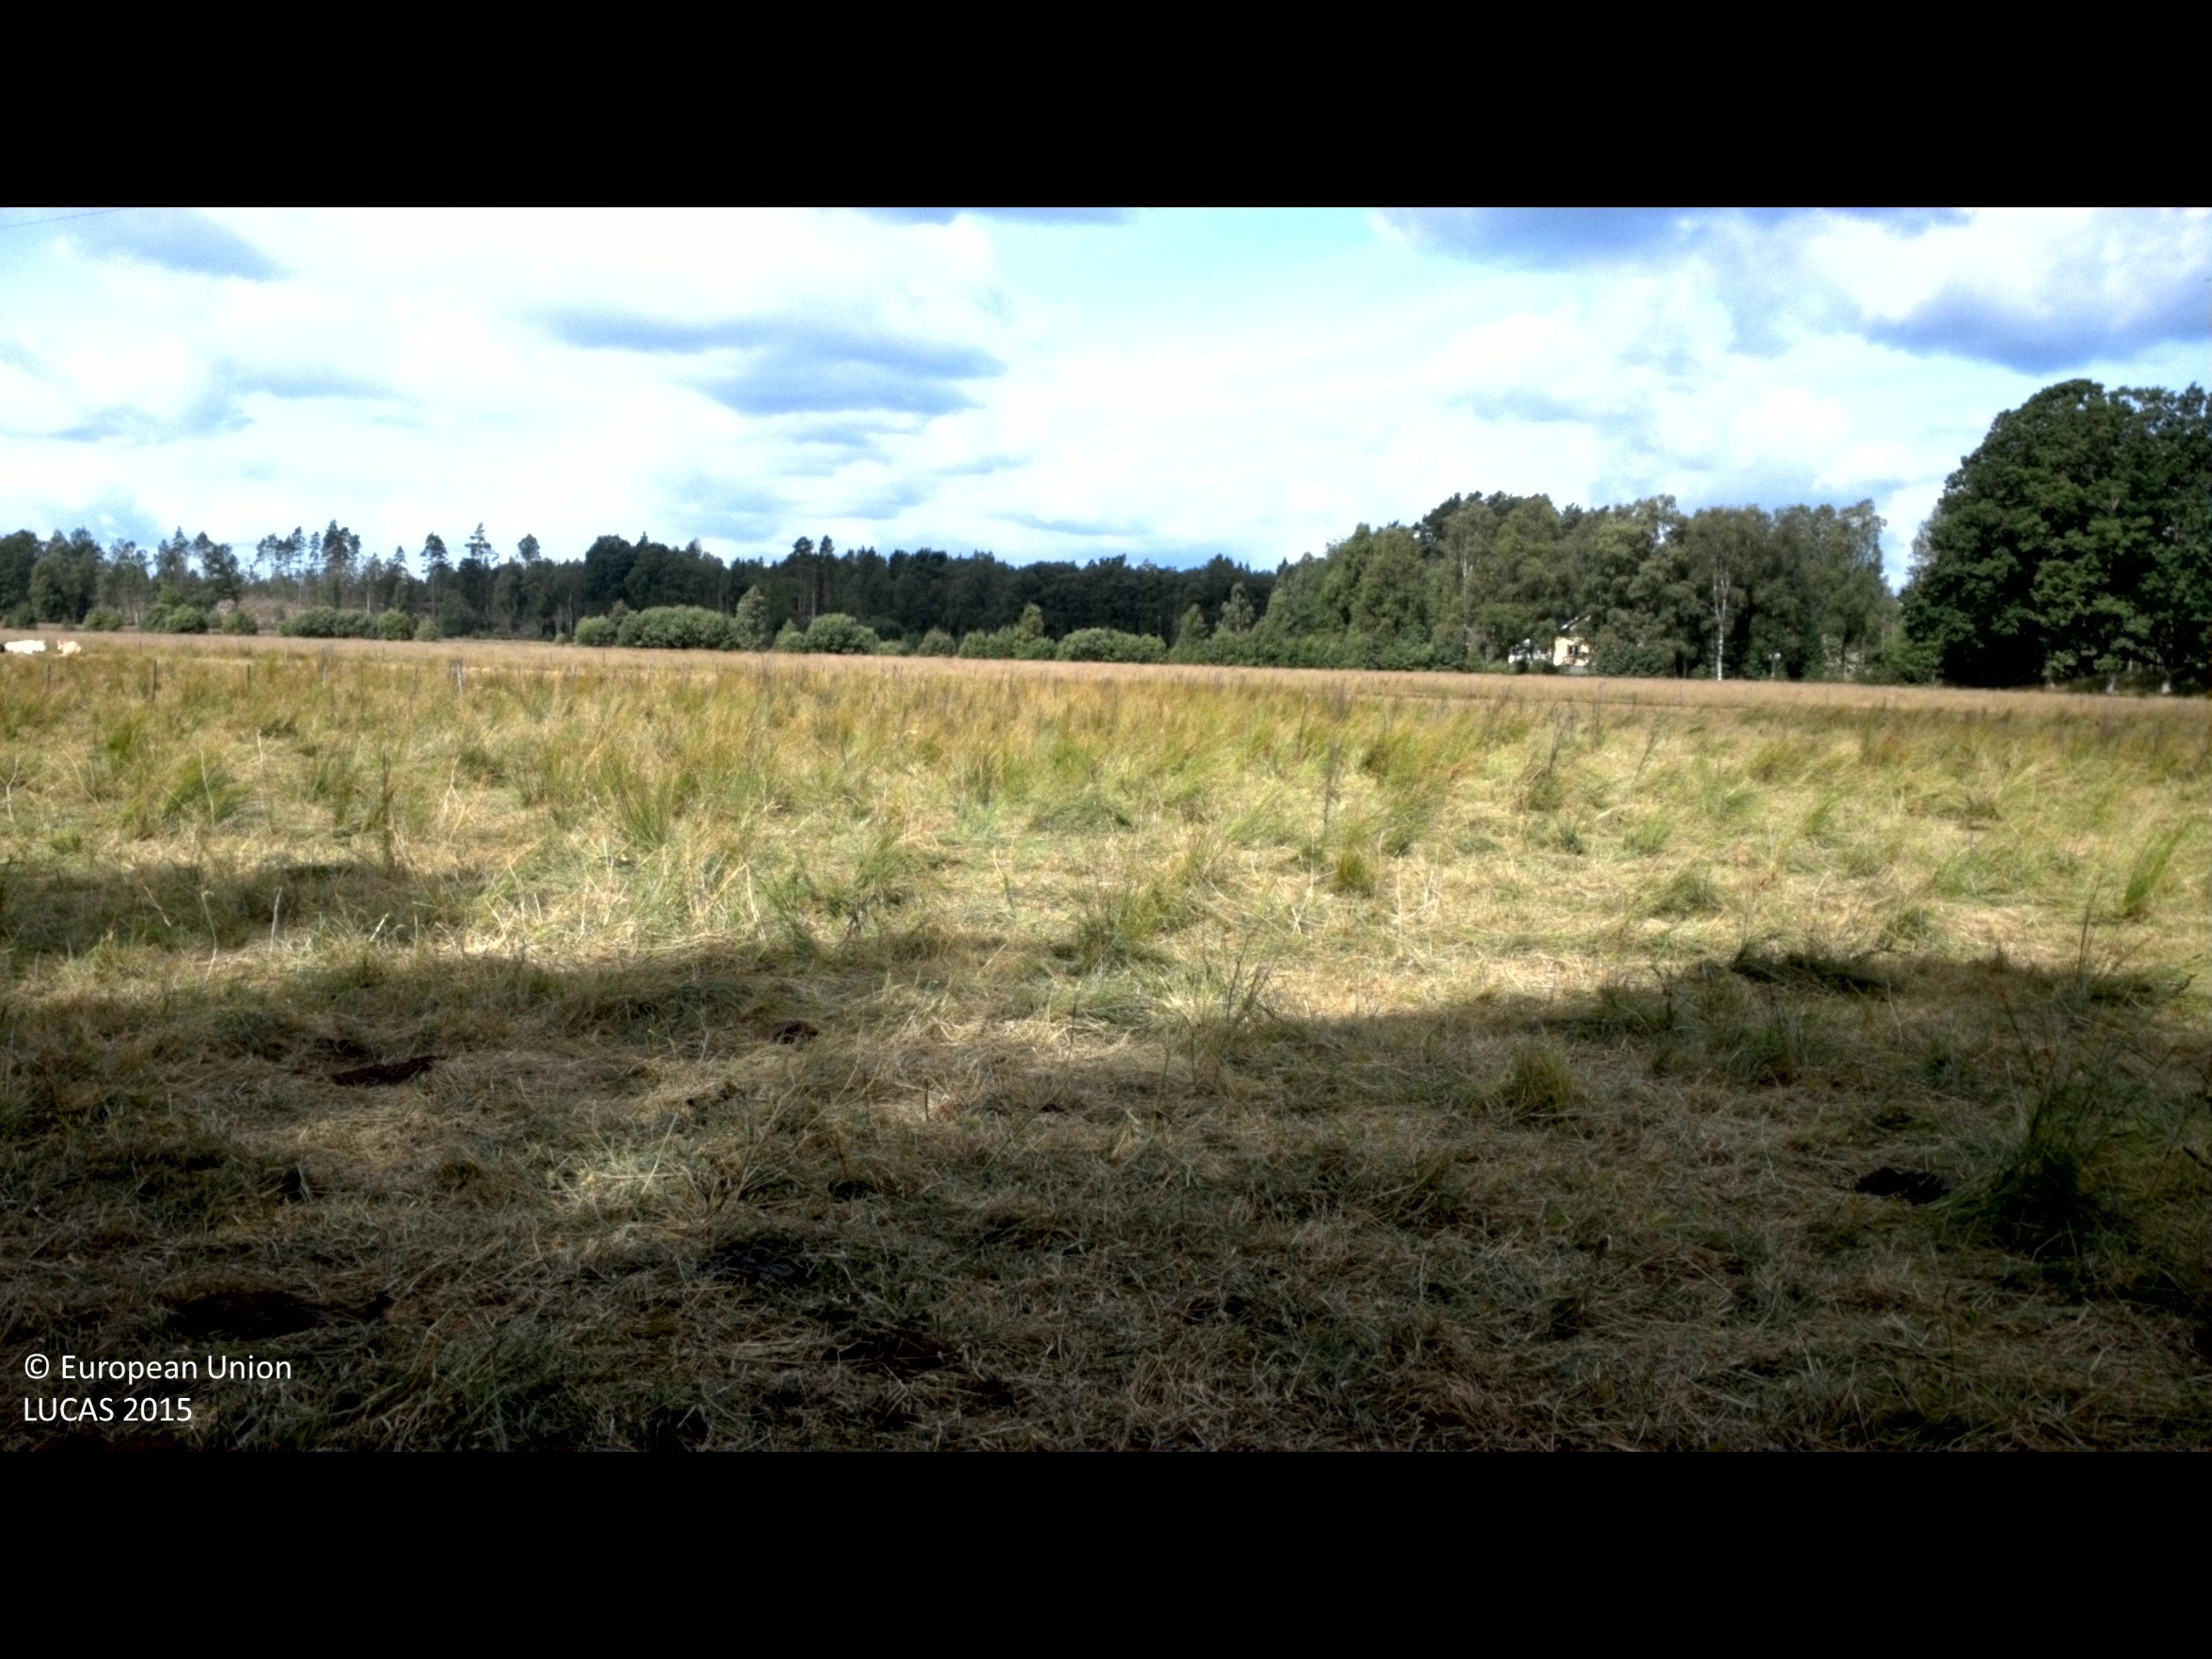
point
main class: Grassland
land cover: Grassland without tree/shrub cover
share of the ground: > 75 %
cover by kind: herbaceous plants 100 %
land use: Agriculture (excluding fallow land and kitchen gardens)
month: July
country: SE
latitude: 56.5476
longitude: 14.3077
